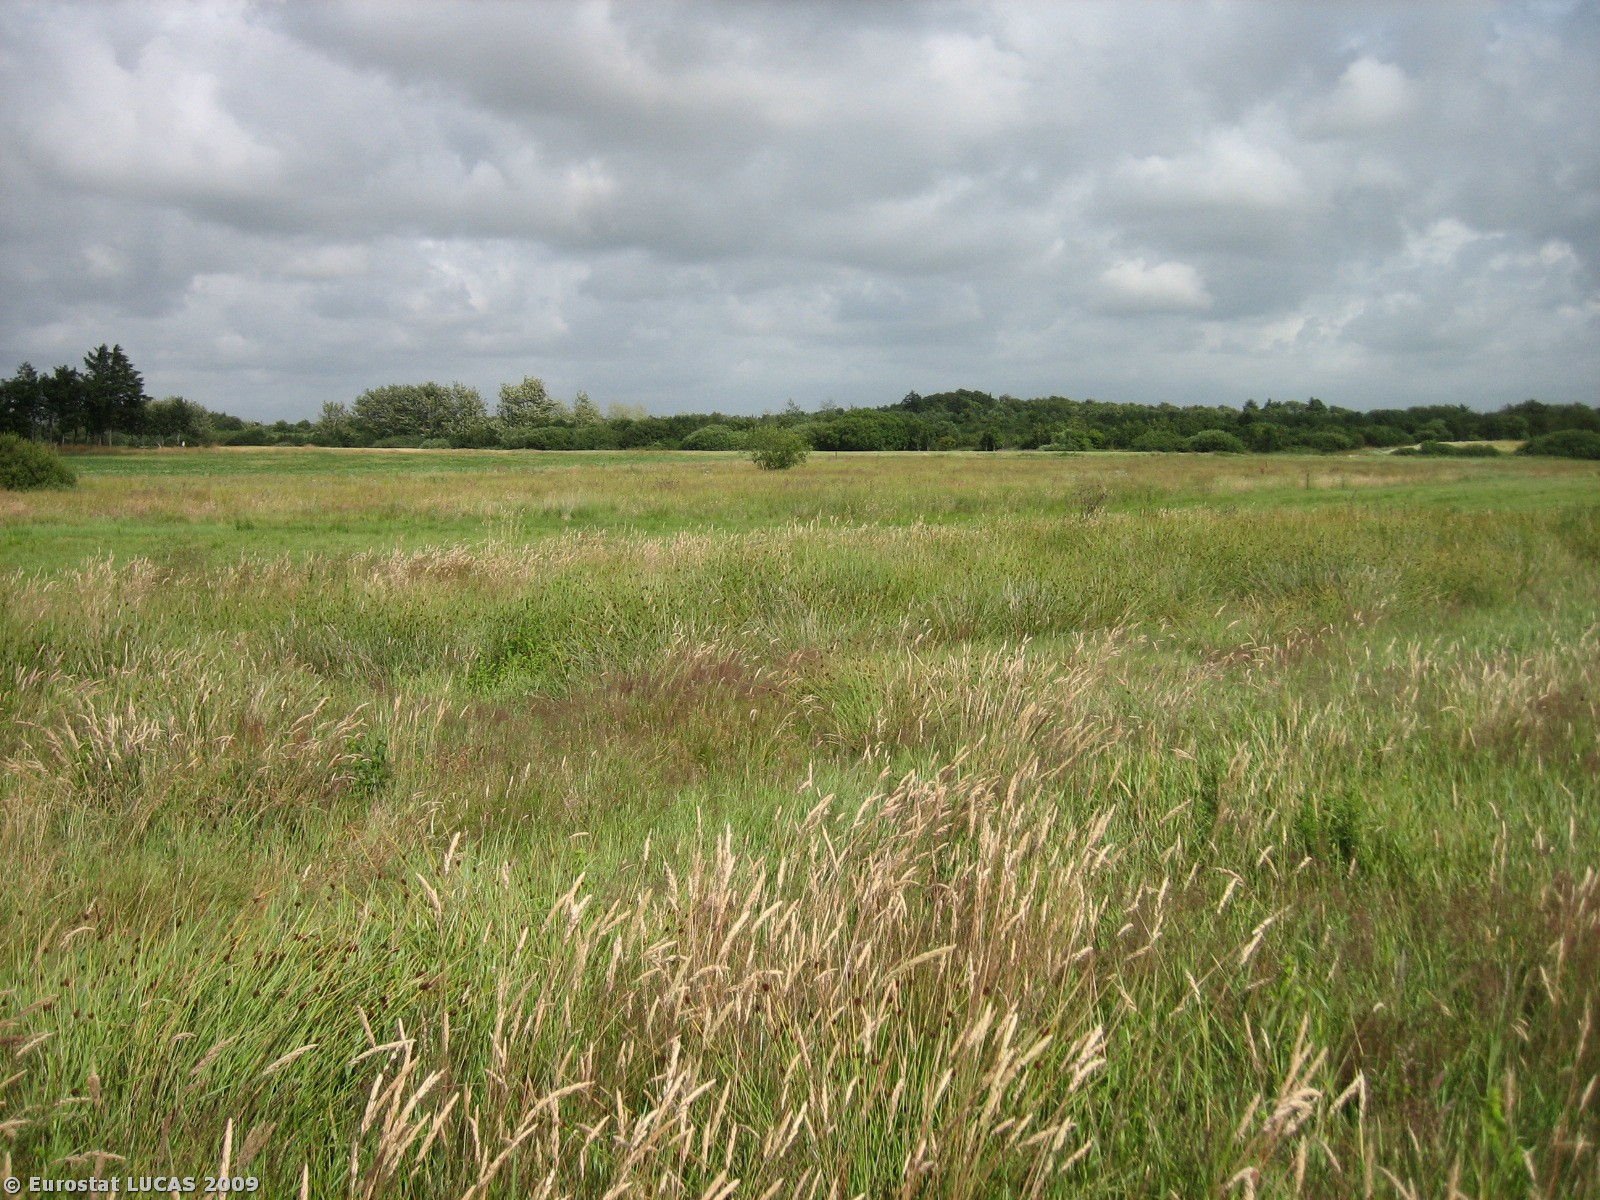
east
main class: Grassland
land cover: Grassland without tree/shrub cover
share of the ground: > 75 %
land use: Unused
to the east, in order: Grassland without tree/shrub cover; Clovers; Grass margins; Barley
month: July
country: DK
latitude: 55.6747
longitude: 8.4272
